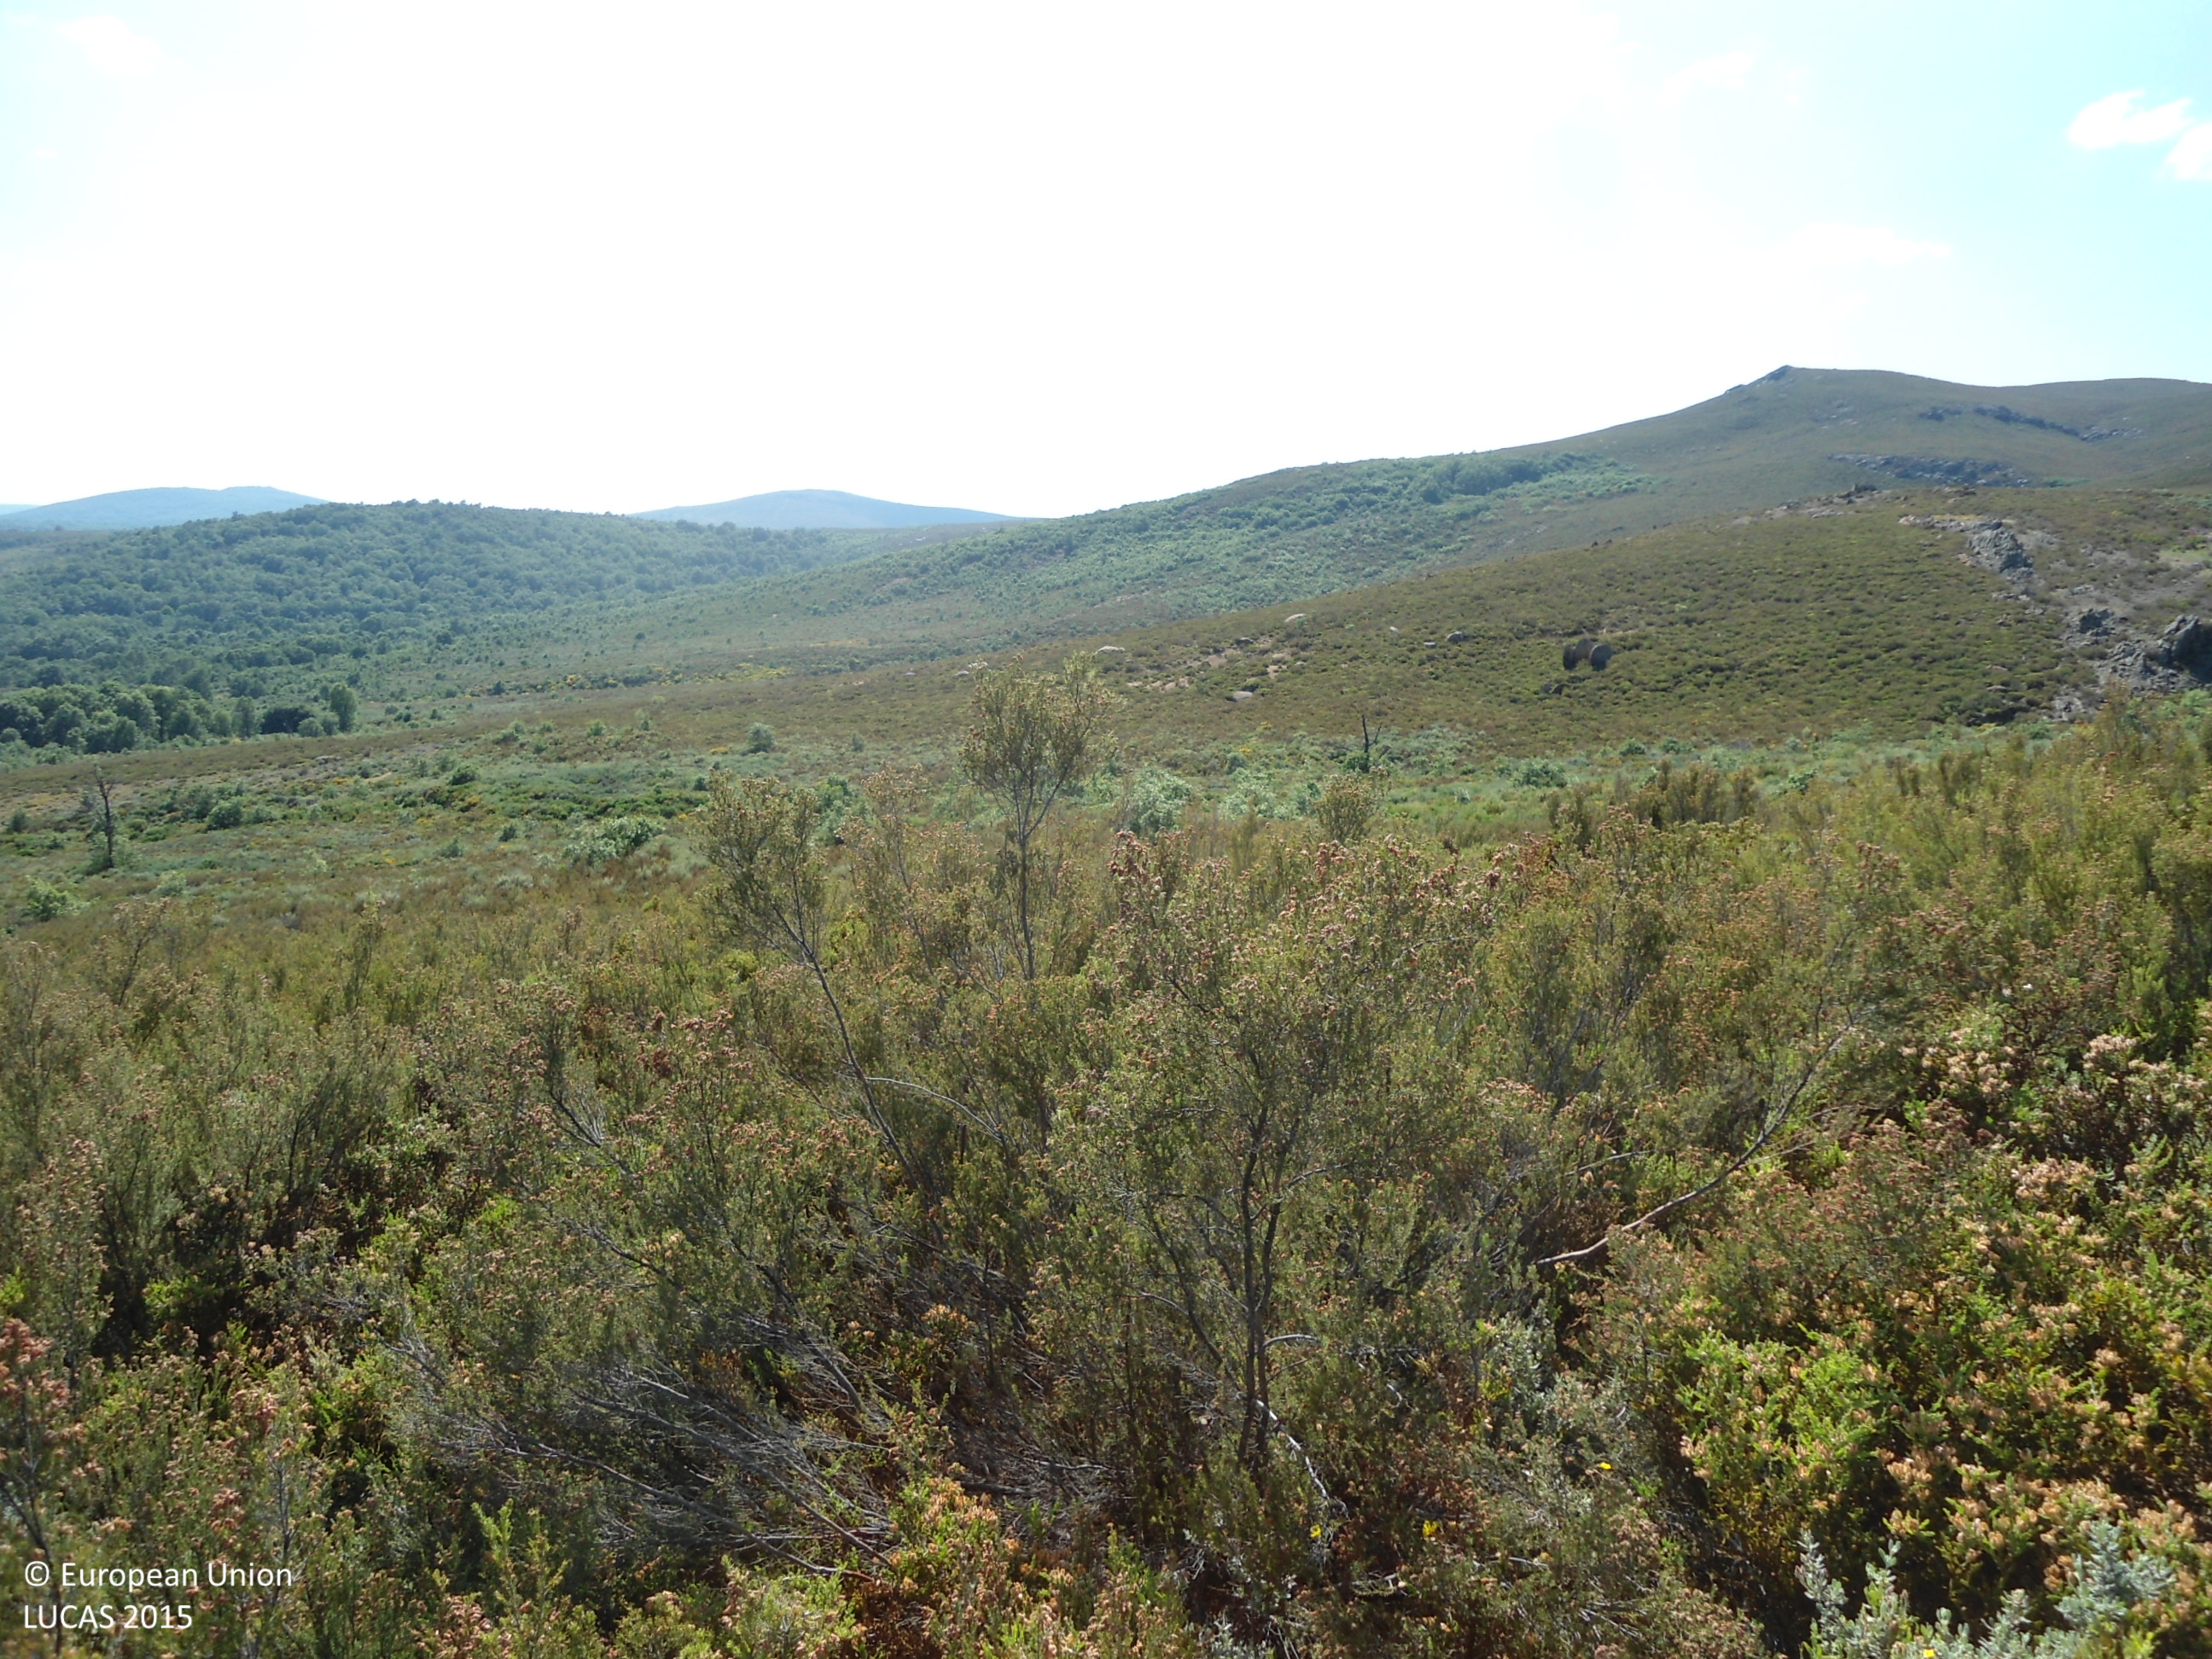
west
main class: Shrubland
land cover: Shrubland without tree cover
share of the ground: > 75 %
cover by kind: shrubs 100 %
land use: Semi-natural and natural areas not in use
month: June
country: ES
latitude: 42.1410
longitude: -6.3582
